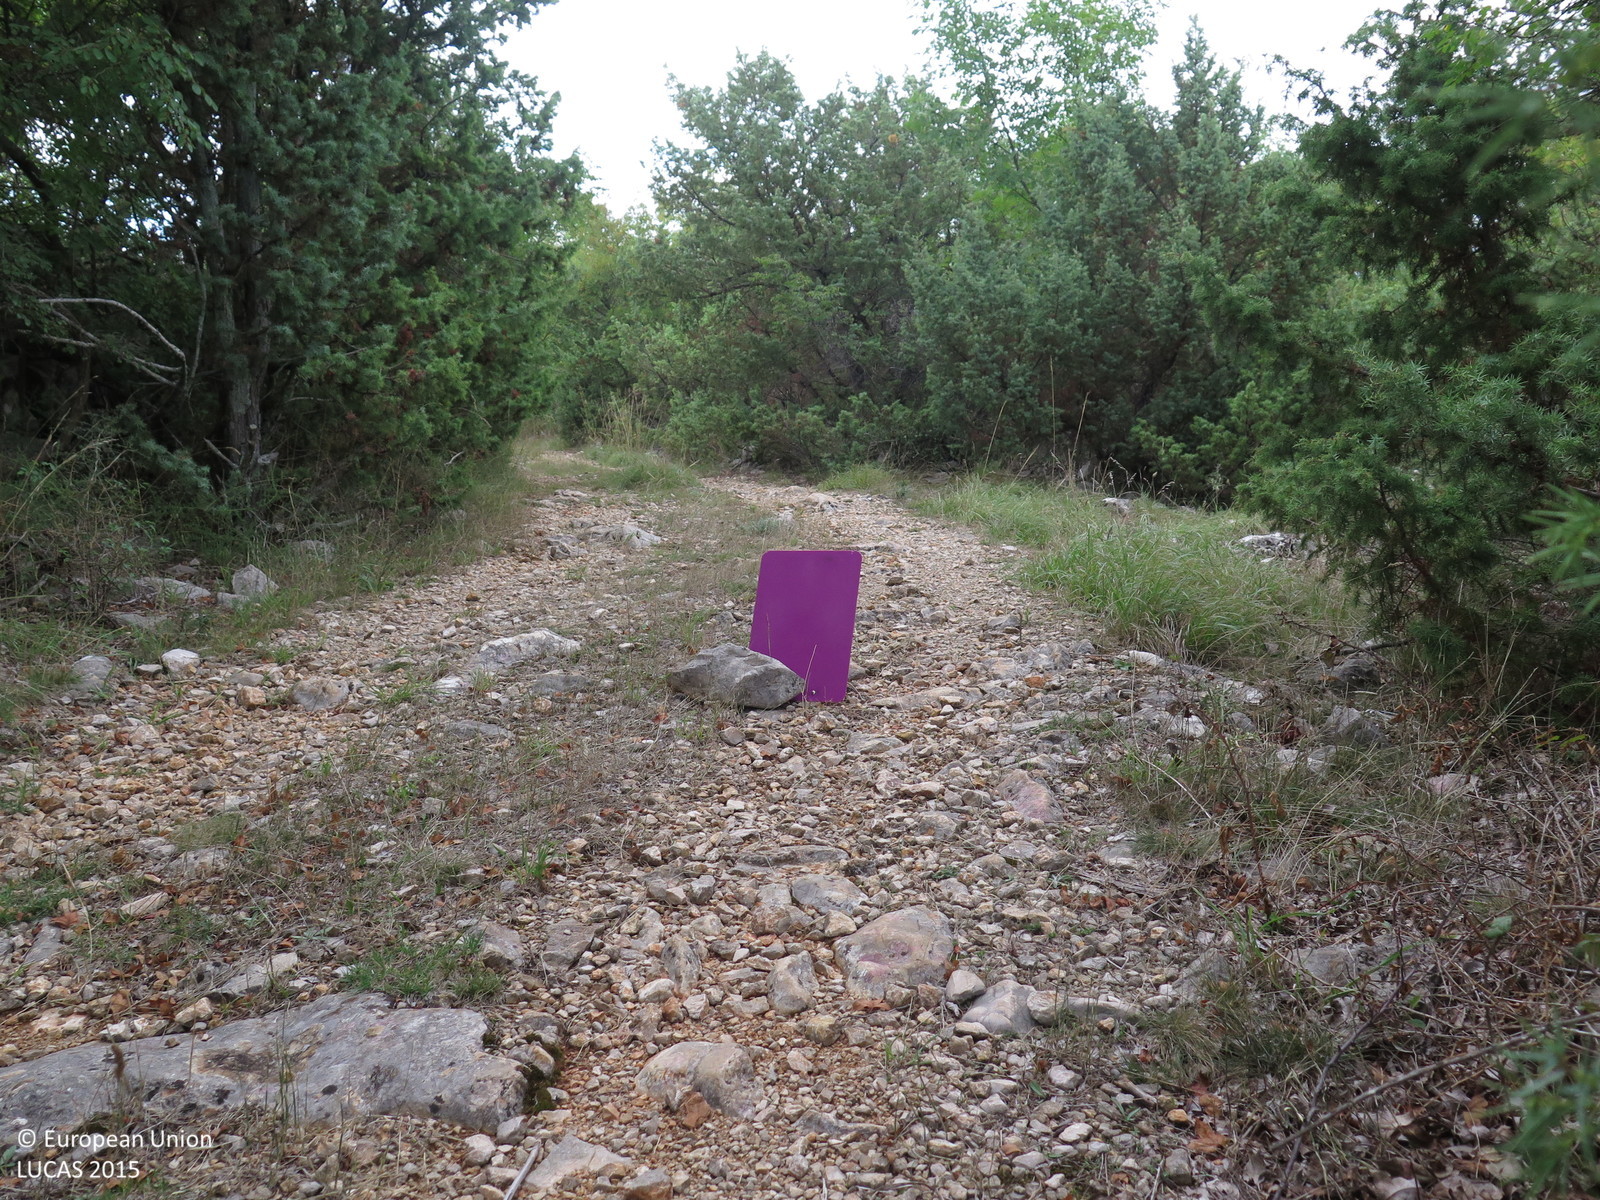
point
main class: Shrubland
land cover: Shrubland with sparse tree cover
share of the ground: > 75 %
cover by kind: shrubs 90 %, broadleaved forest trees 5 %, herbaceous plants 5 %
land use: Semi-natural and natural areas not in use
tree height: < 5 m
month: August
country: HR
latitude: 45.0599
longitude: 14.6296
